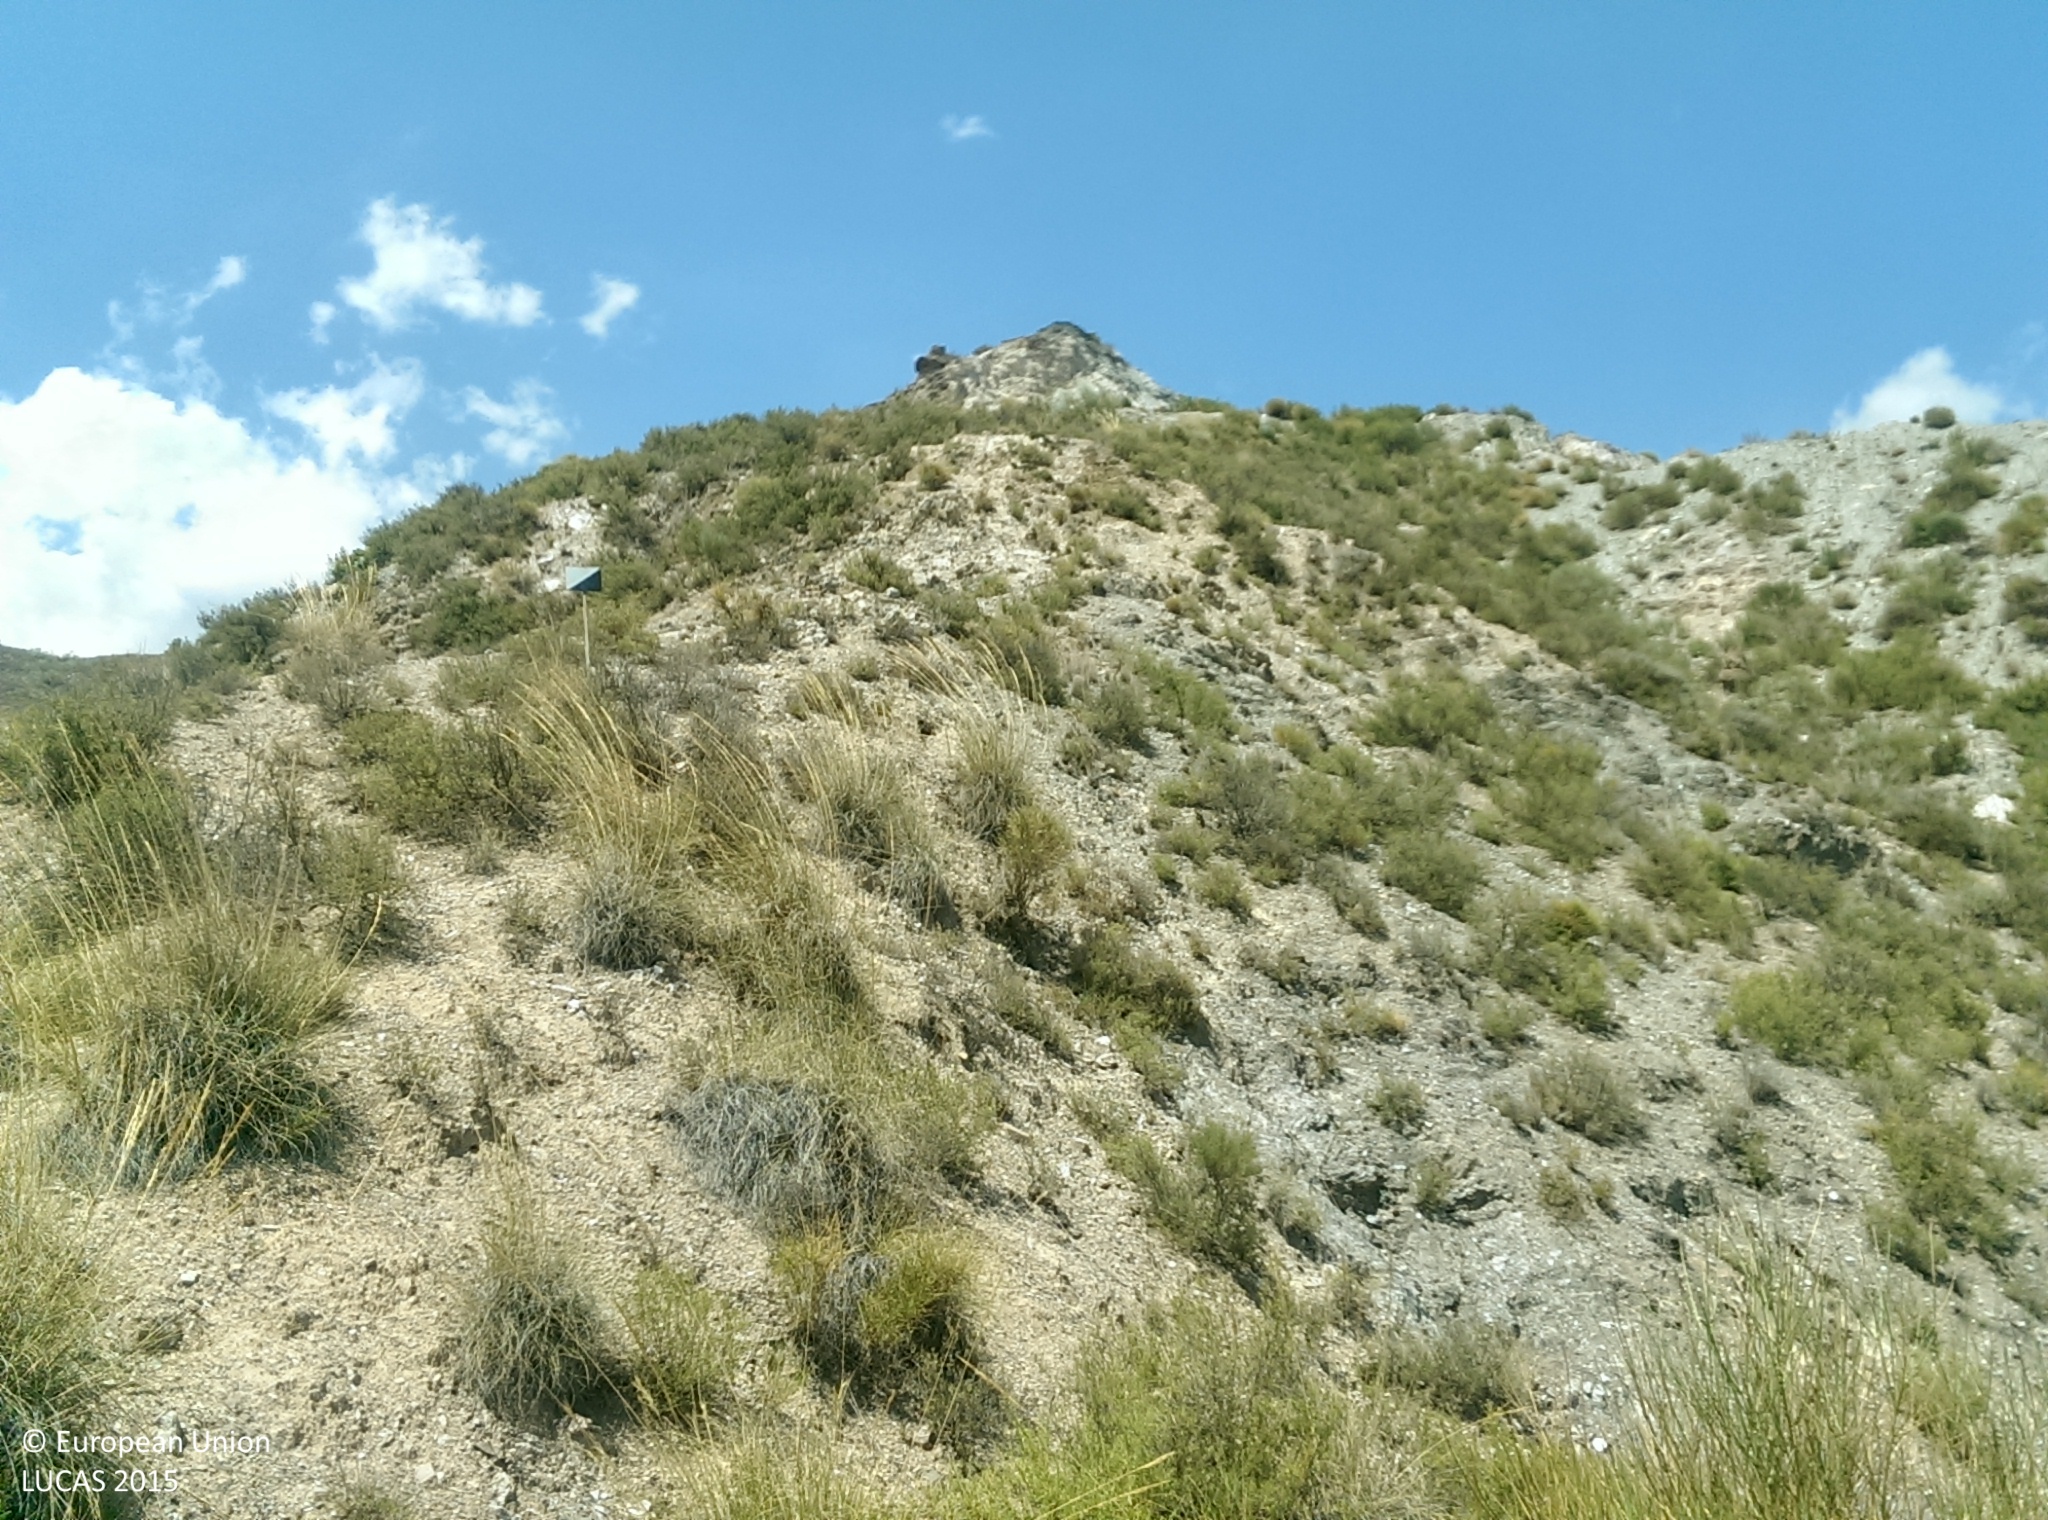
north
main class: Shrubland
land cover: Shrubland without tree cover
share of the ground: 50 - 75 %
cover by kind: shrubs 60 %, herbaceous plants 30 %, unconsolidated bare surface 10 %
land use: Semi-natural and natural areas not in use
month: July
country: ES
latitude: 36.9577
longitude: -3.1556
